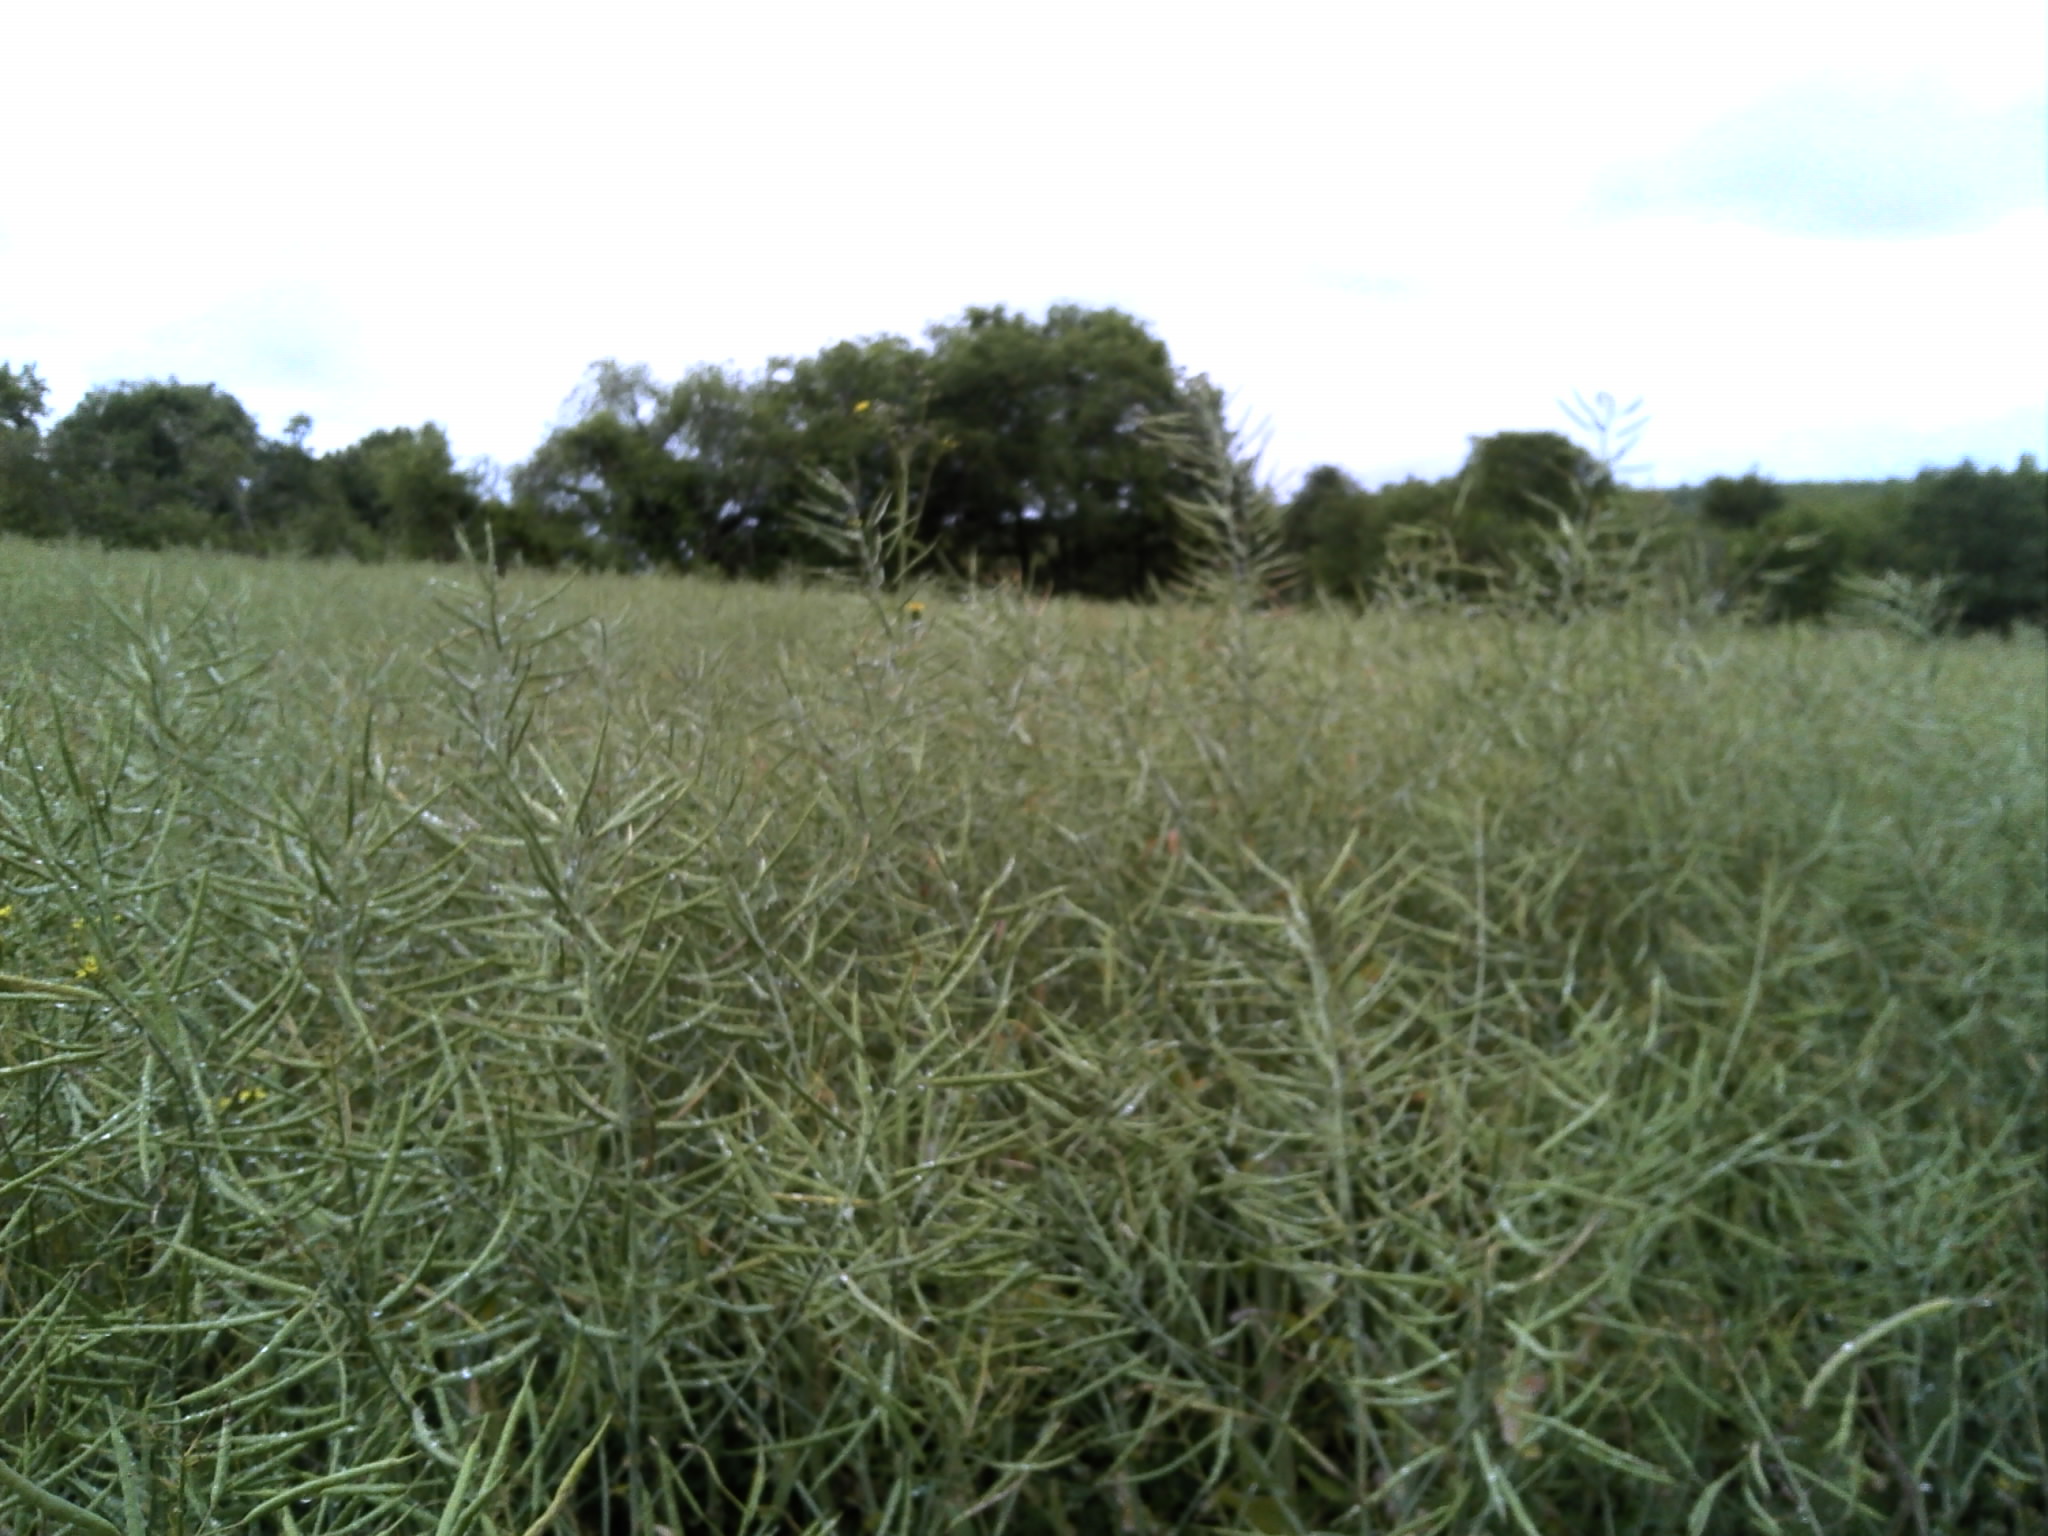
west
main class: Cropland
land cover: Rape and turnip rape
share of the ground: > 75 %
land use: Agriculture (excluding fallow land and kitchen gardens)
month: June
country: FR
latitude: 46.6290
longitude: 1.5126
